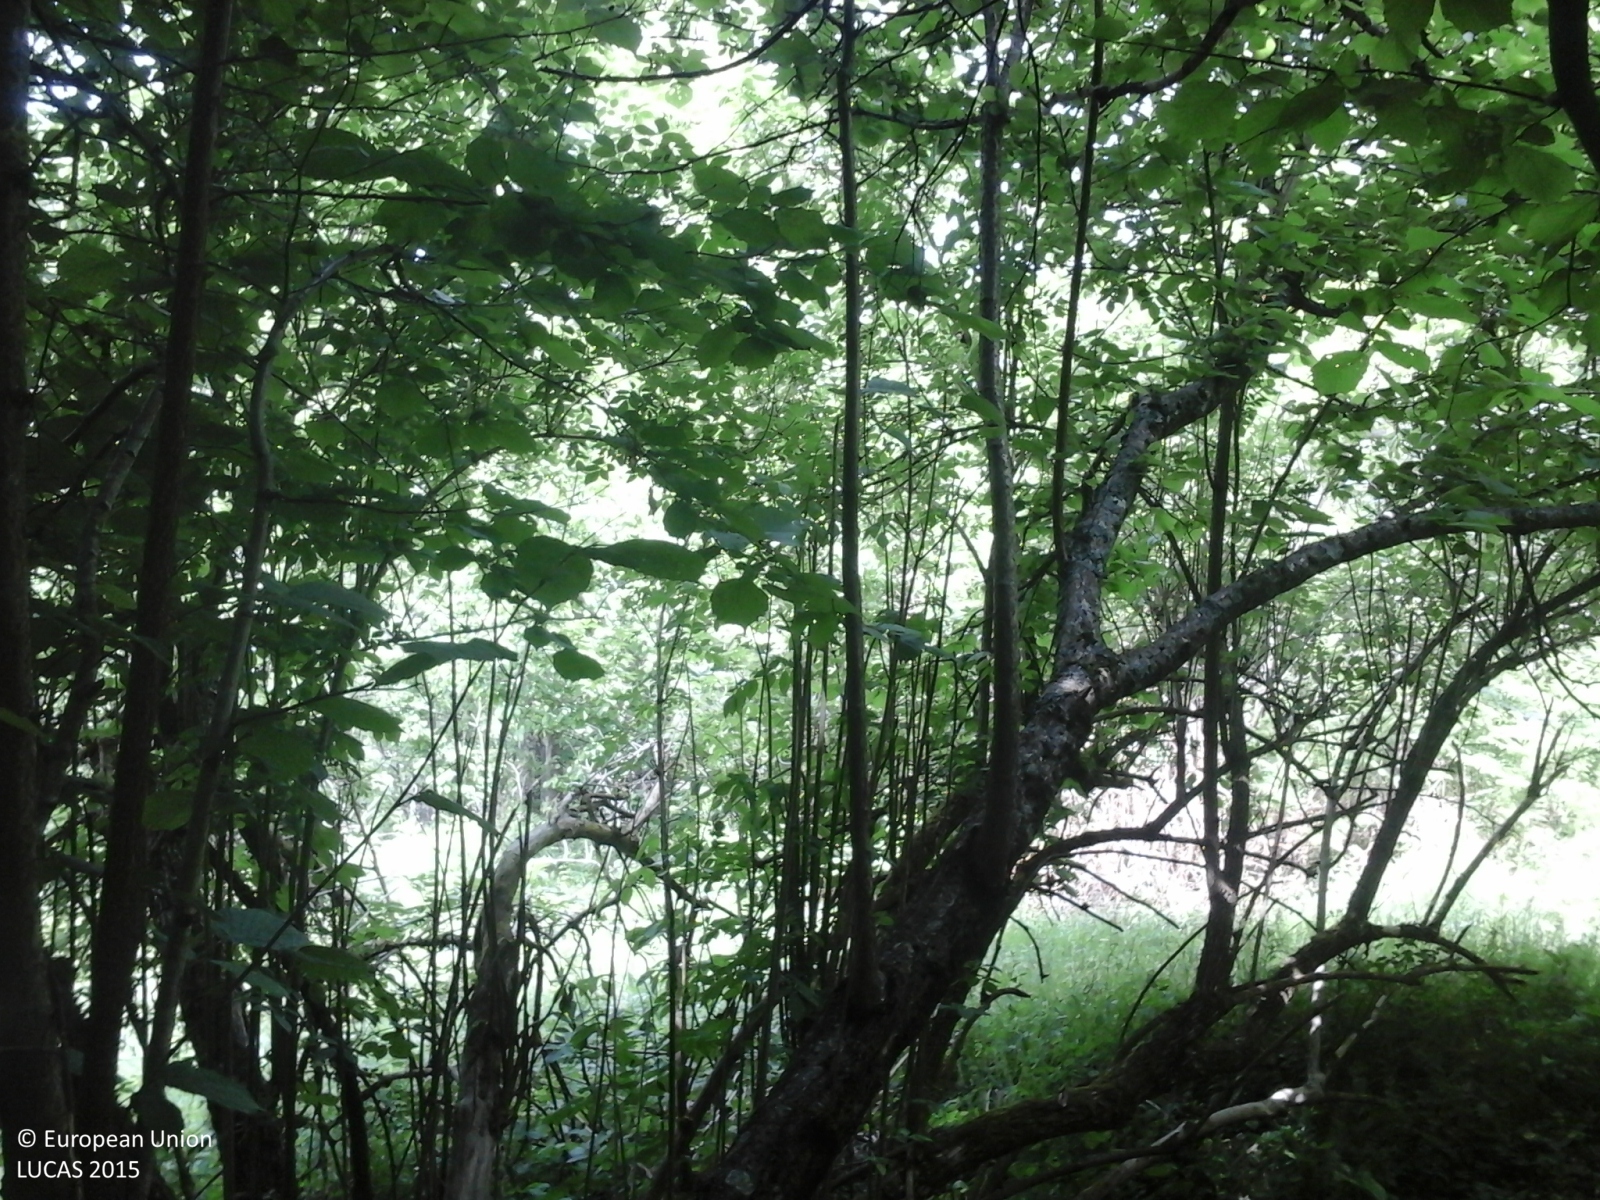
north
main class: Woodland
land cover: Broadleaved woodland
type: thermophilous deciduous forest
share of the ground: > 75 %
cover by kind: broadleaved forest trees 80 %, herbaceous plants 20 %
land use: Forestry
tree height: > 5 m
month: May
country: IT
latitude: 44.4222
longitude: 9.6867
